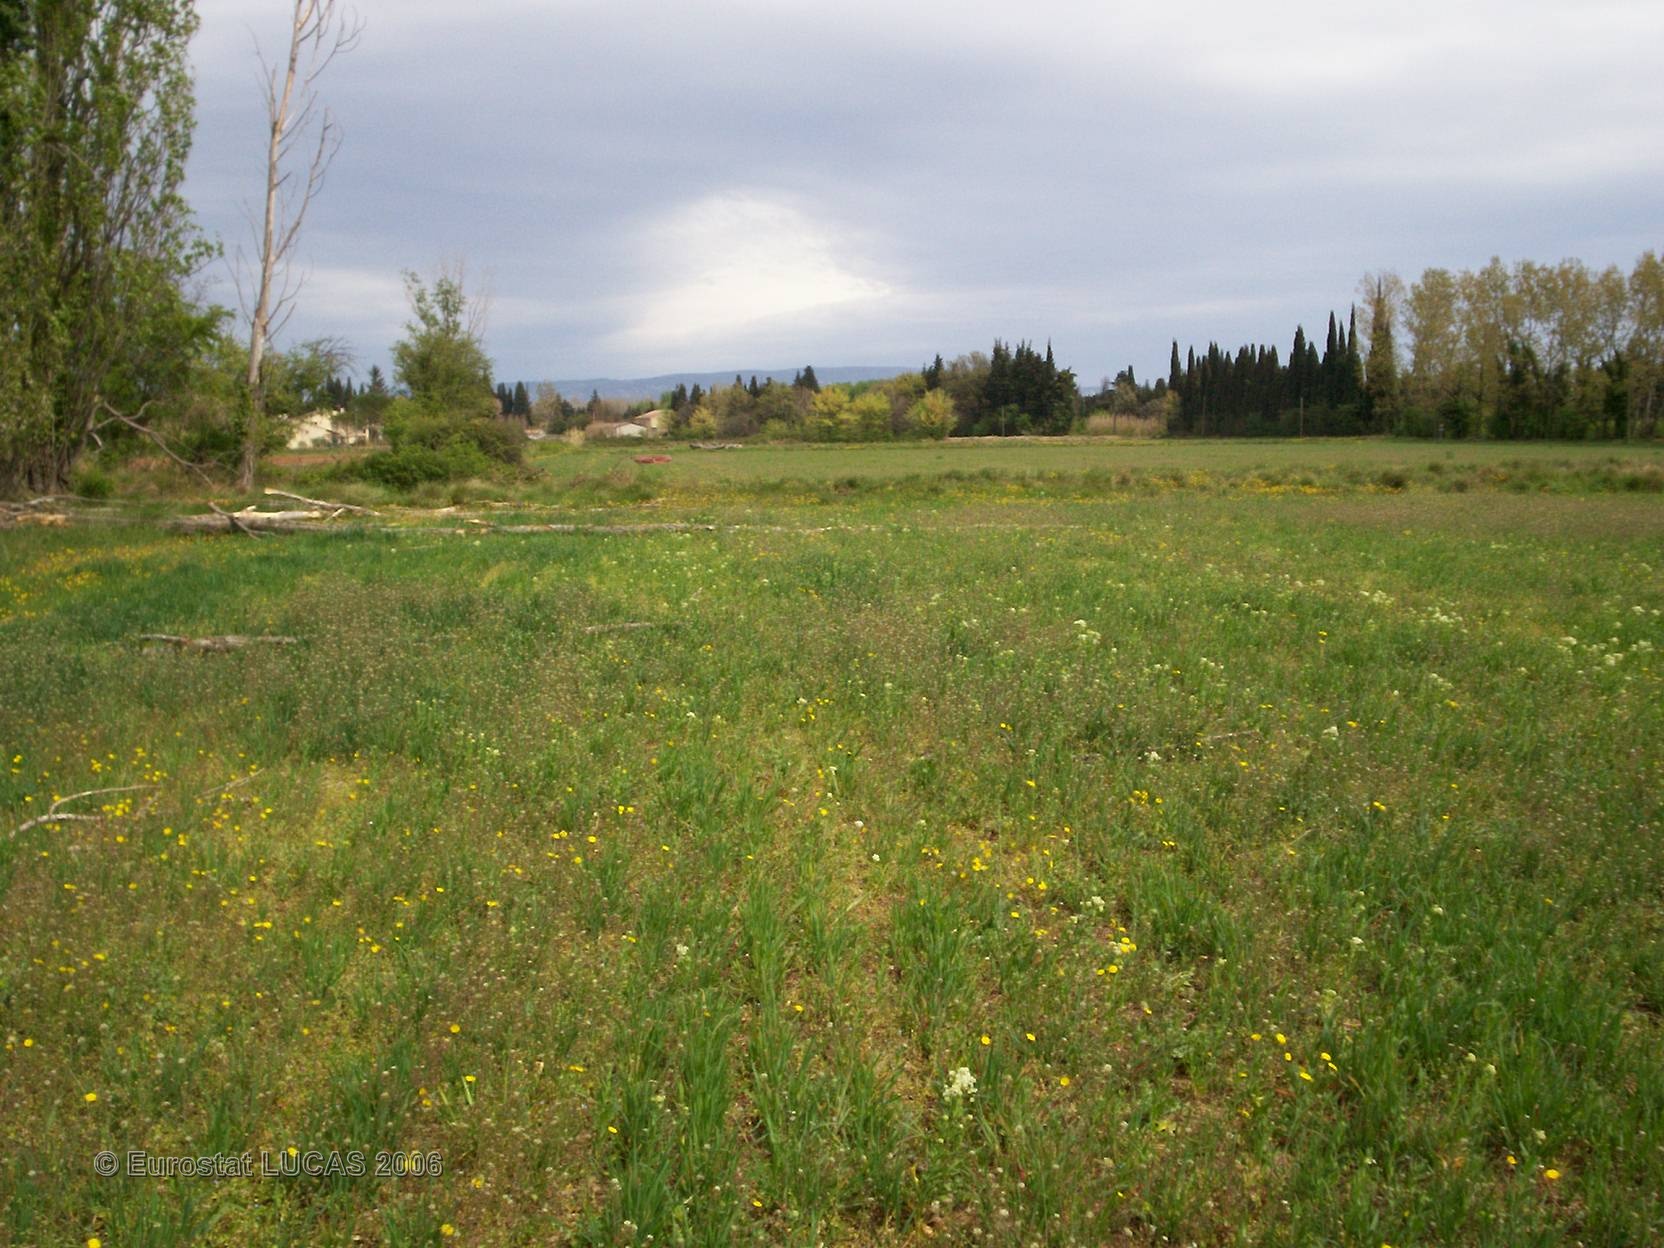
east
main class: Cropland
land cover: Oats
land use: Agriculture (excluding fallow land and kitchen gardens)
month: April
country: FR
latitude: 43.8132
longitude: 4.9741
